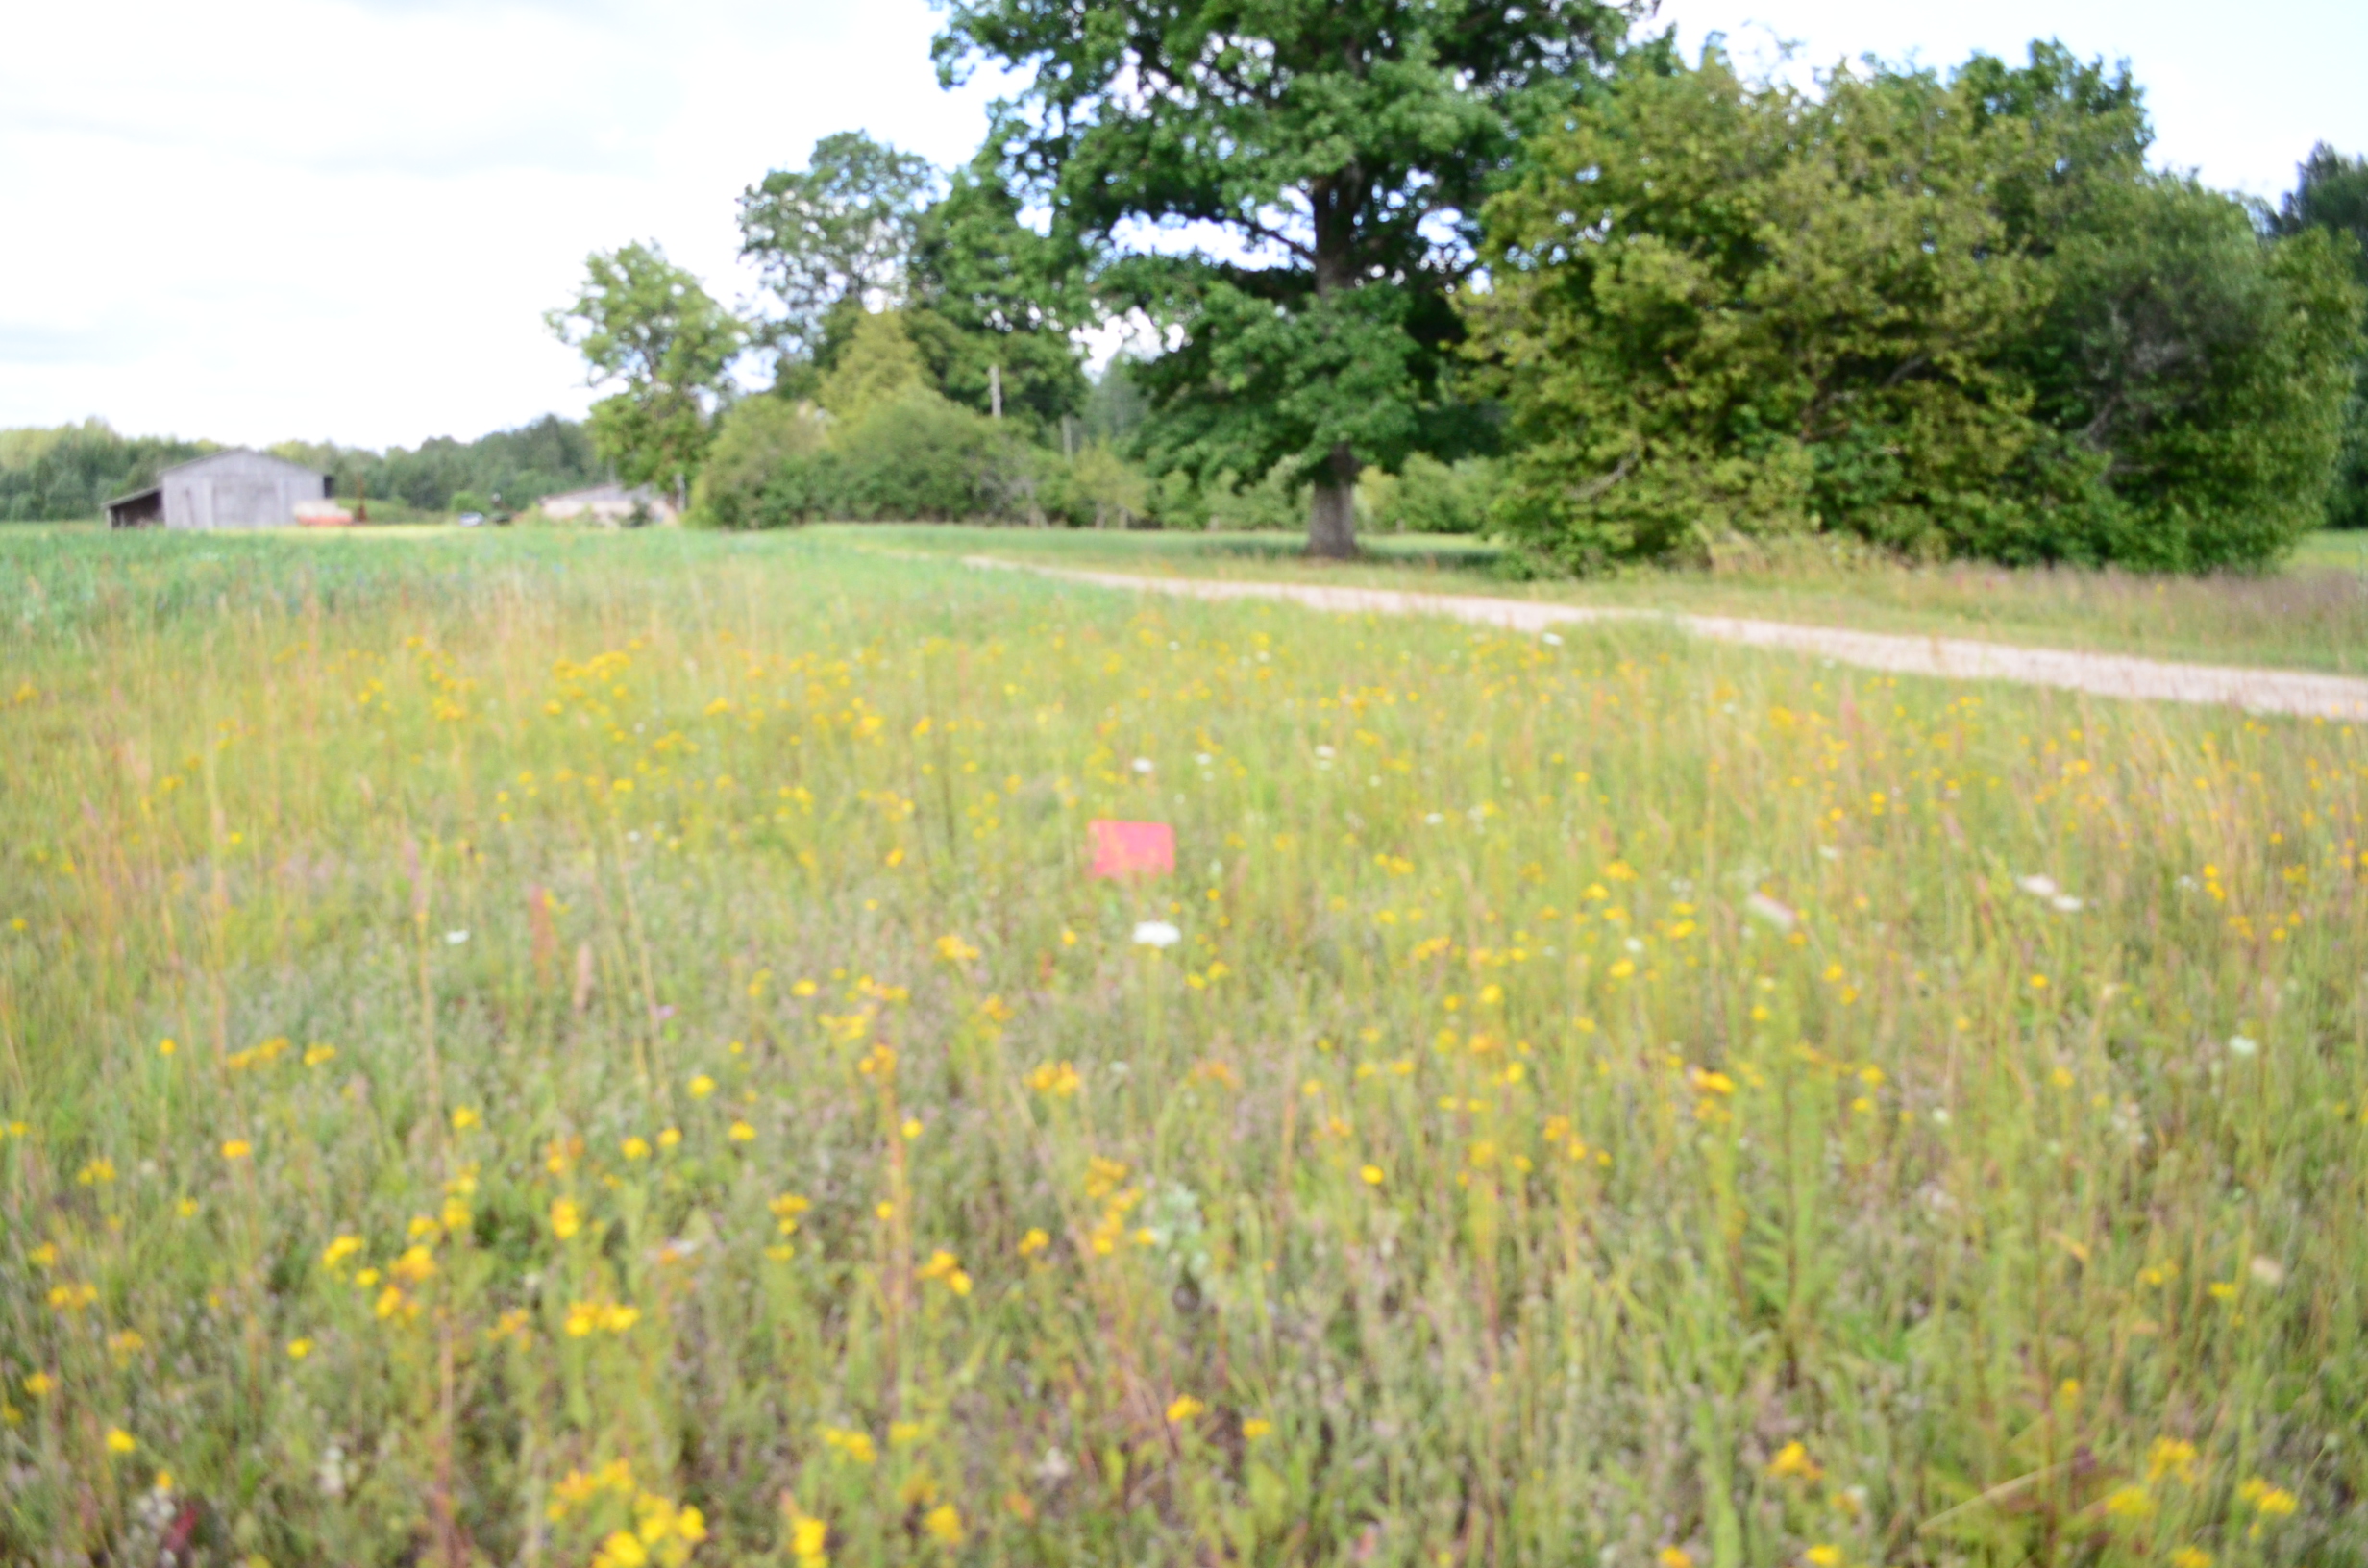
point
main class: Grassland
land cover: Grassland without tree/shrub cover
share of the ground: > 75 %
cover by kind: herbaceous plants 100 %
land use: Agriculture (excluding fallow land and kitchen gardens)
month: July
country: LV
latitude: 57.0703
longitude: 22.4742
